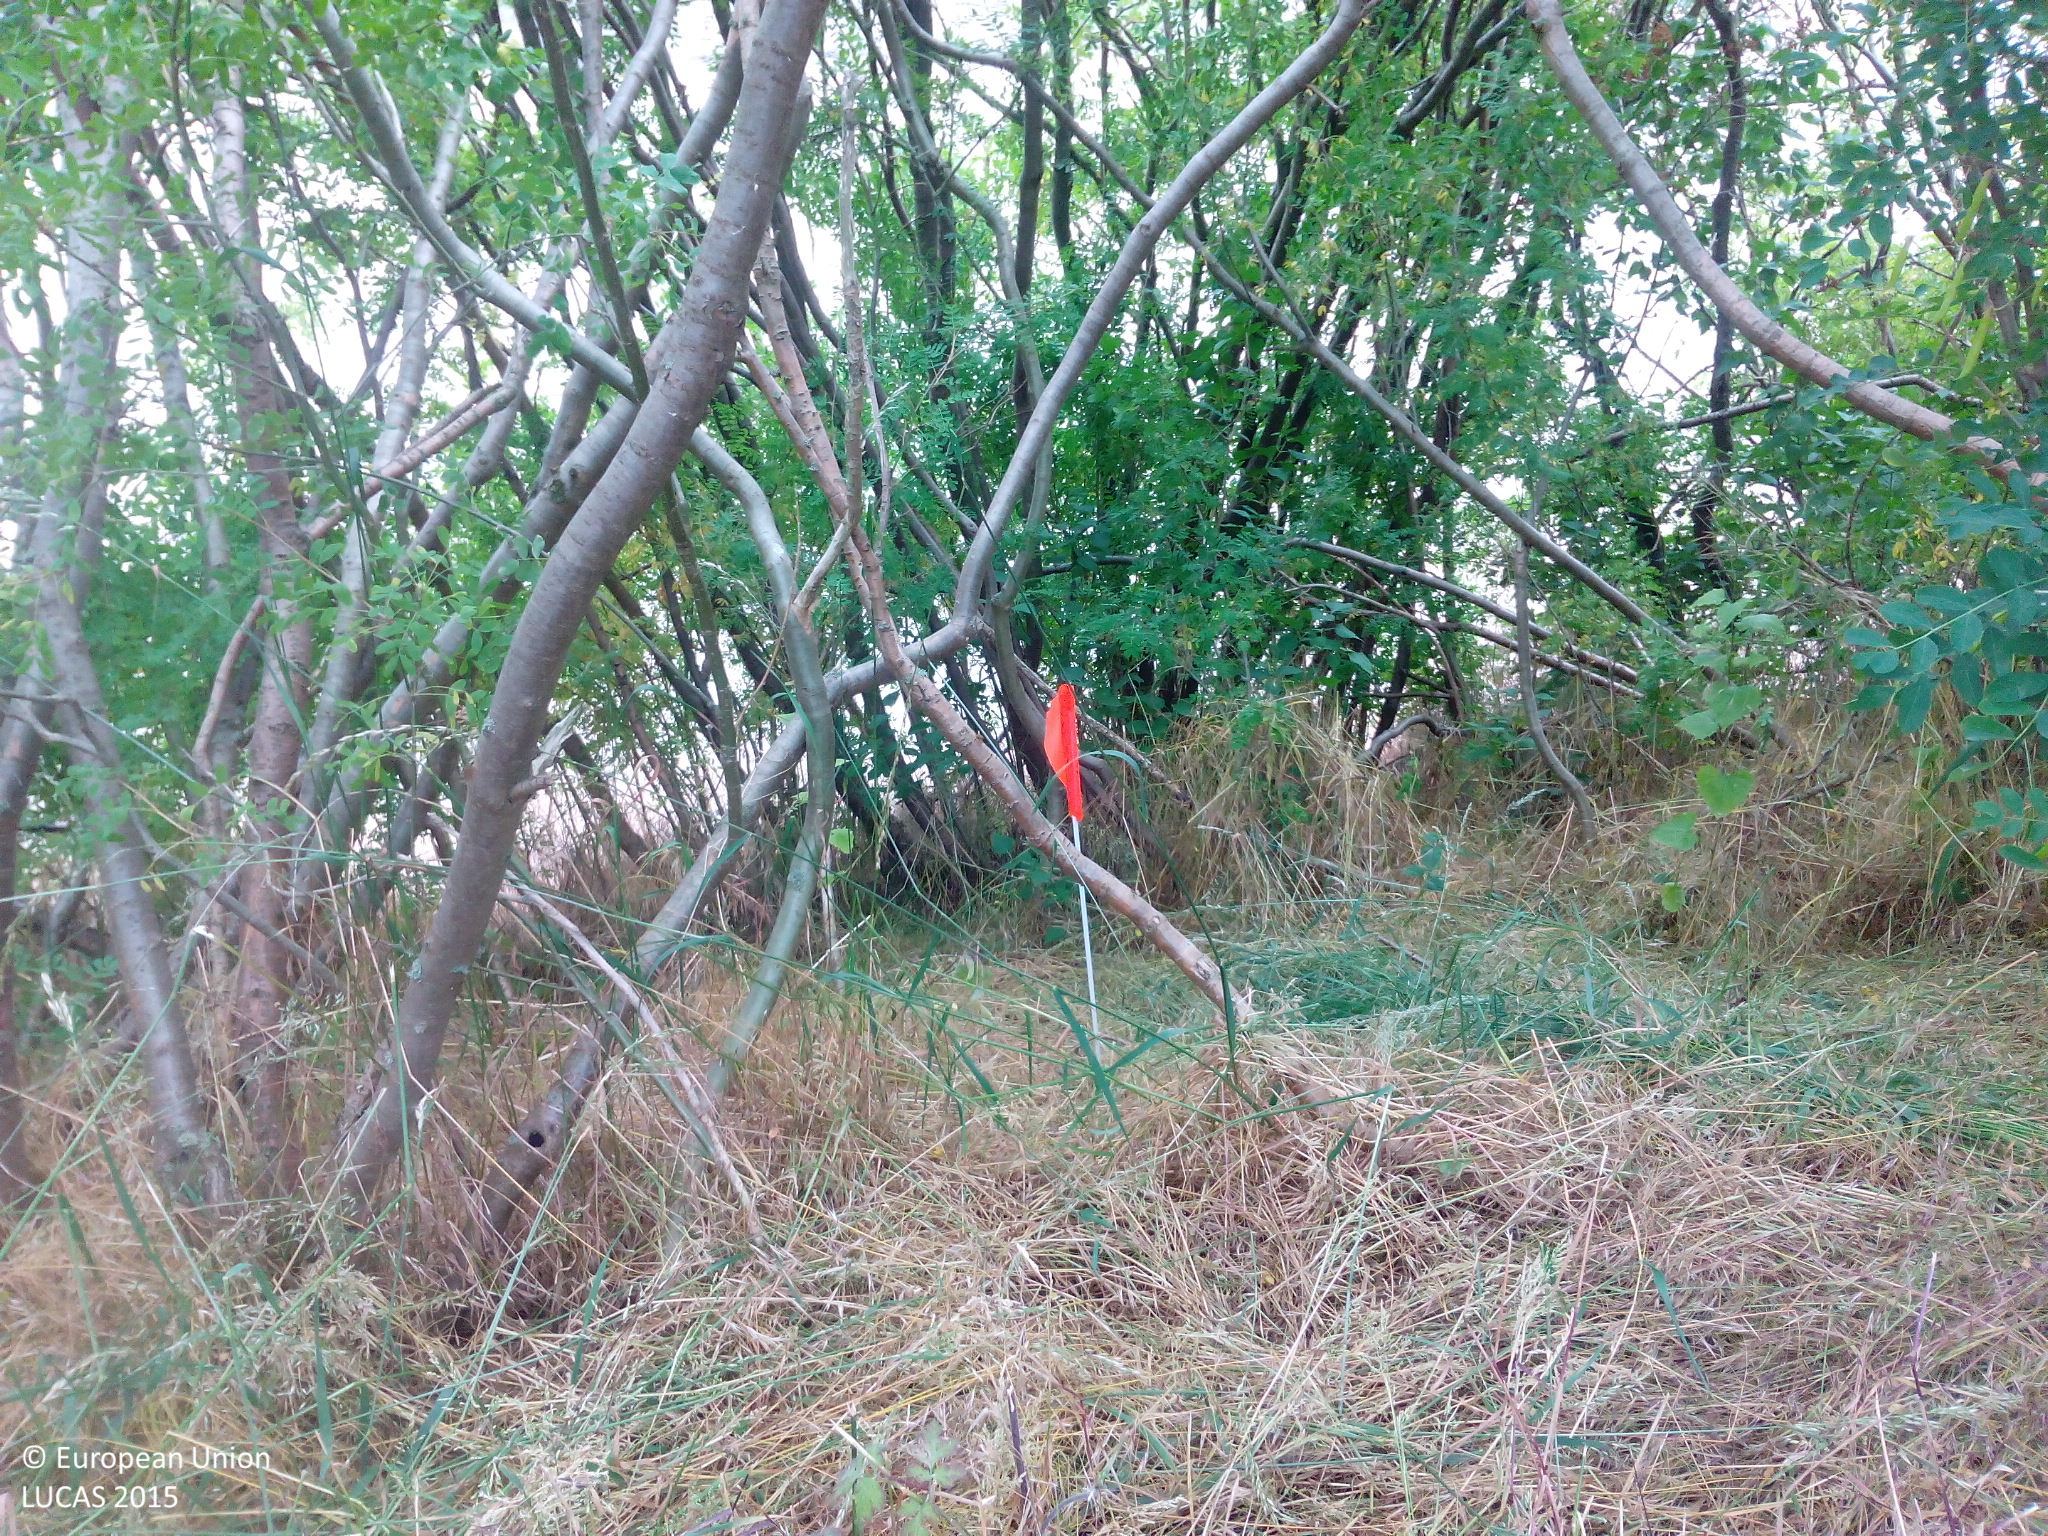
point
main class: Woodland
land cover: Broadleaved woodland
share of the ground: > 75 %
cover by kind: broadleaved forest trees 75 %, herbaceous plants 25 %
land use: Other primary production
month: June
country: DE
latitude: 53.8636
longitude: 11.1702
